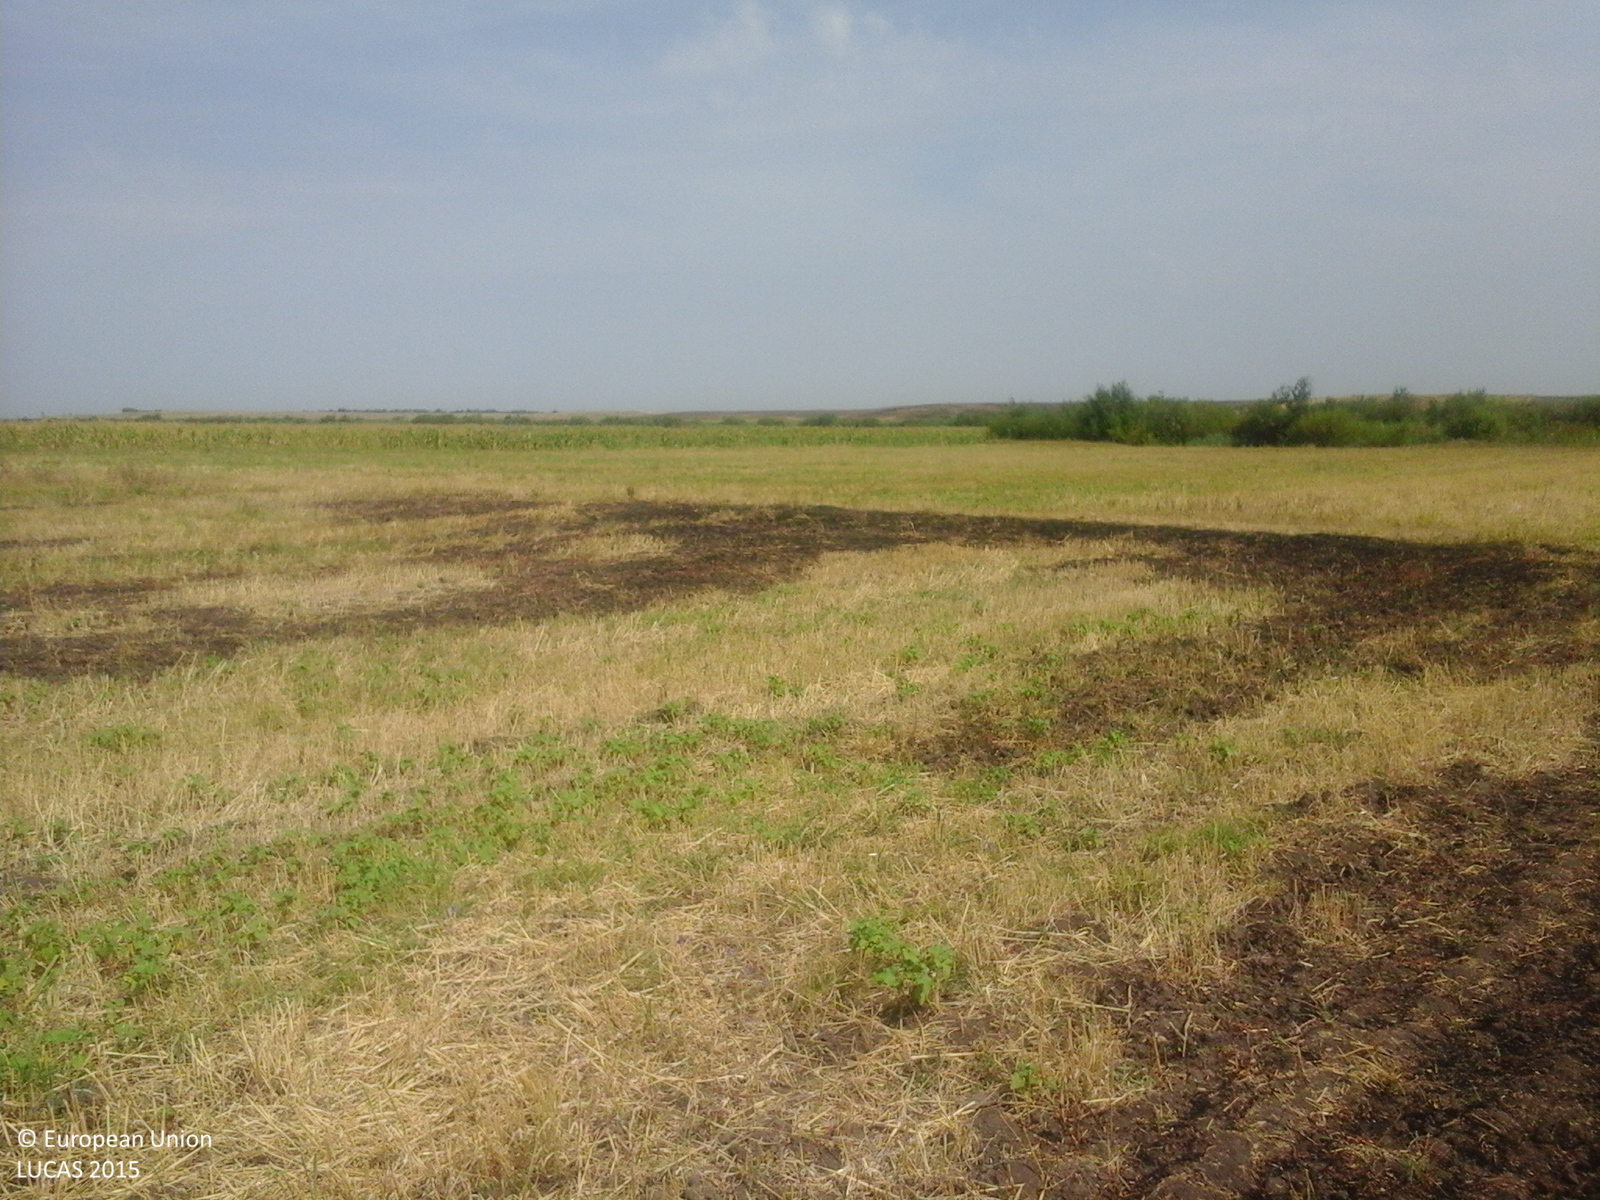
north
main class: Cropland
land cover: Barley
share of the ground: < 10 %
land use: Agriculture (excluding fallow land and kitchen gardens)
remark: Burnt area
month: August
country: RO
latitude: 44.2464
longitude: 22.9538
